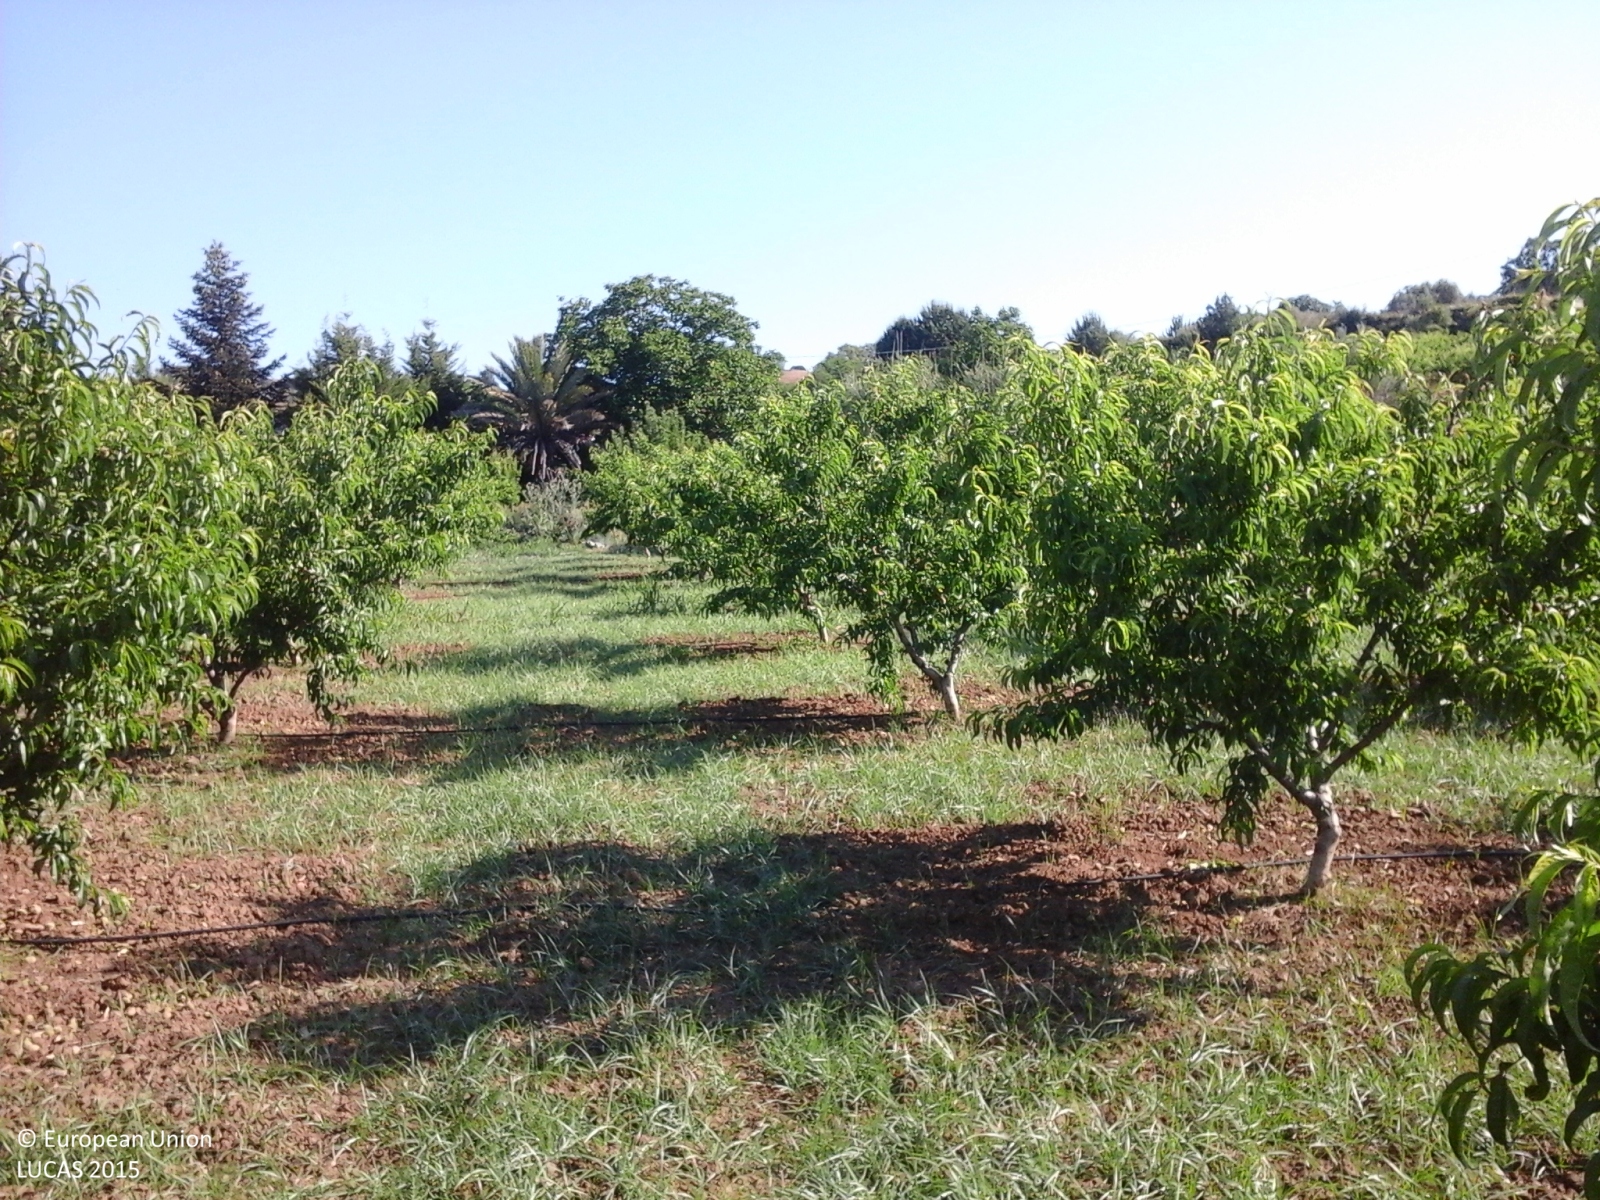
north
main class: Cropland
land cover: Other fruit trees and berries
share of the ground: 25 - 50 %
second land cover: Other bare soil
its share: > 75 %
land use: Agriculture (excluding fallow land and kitchen gardens)
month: June
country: IT
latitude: 37.3536
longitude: 14.4260
